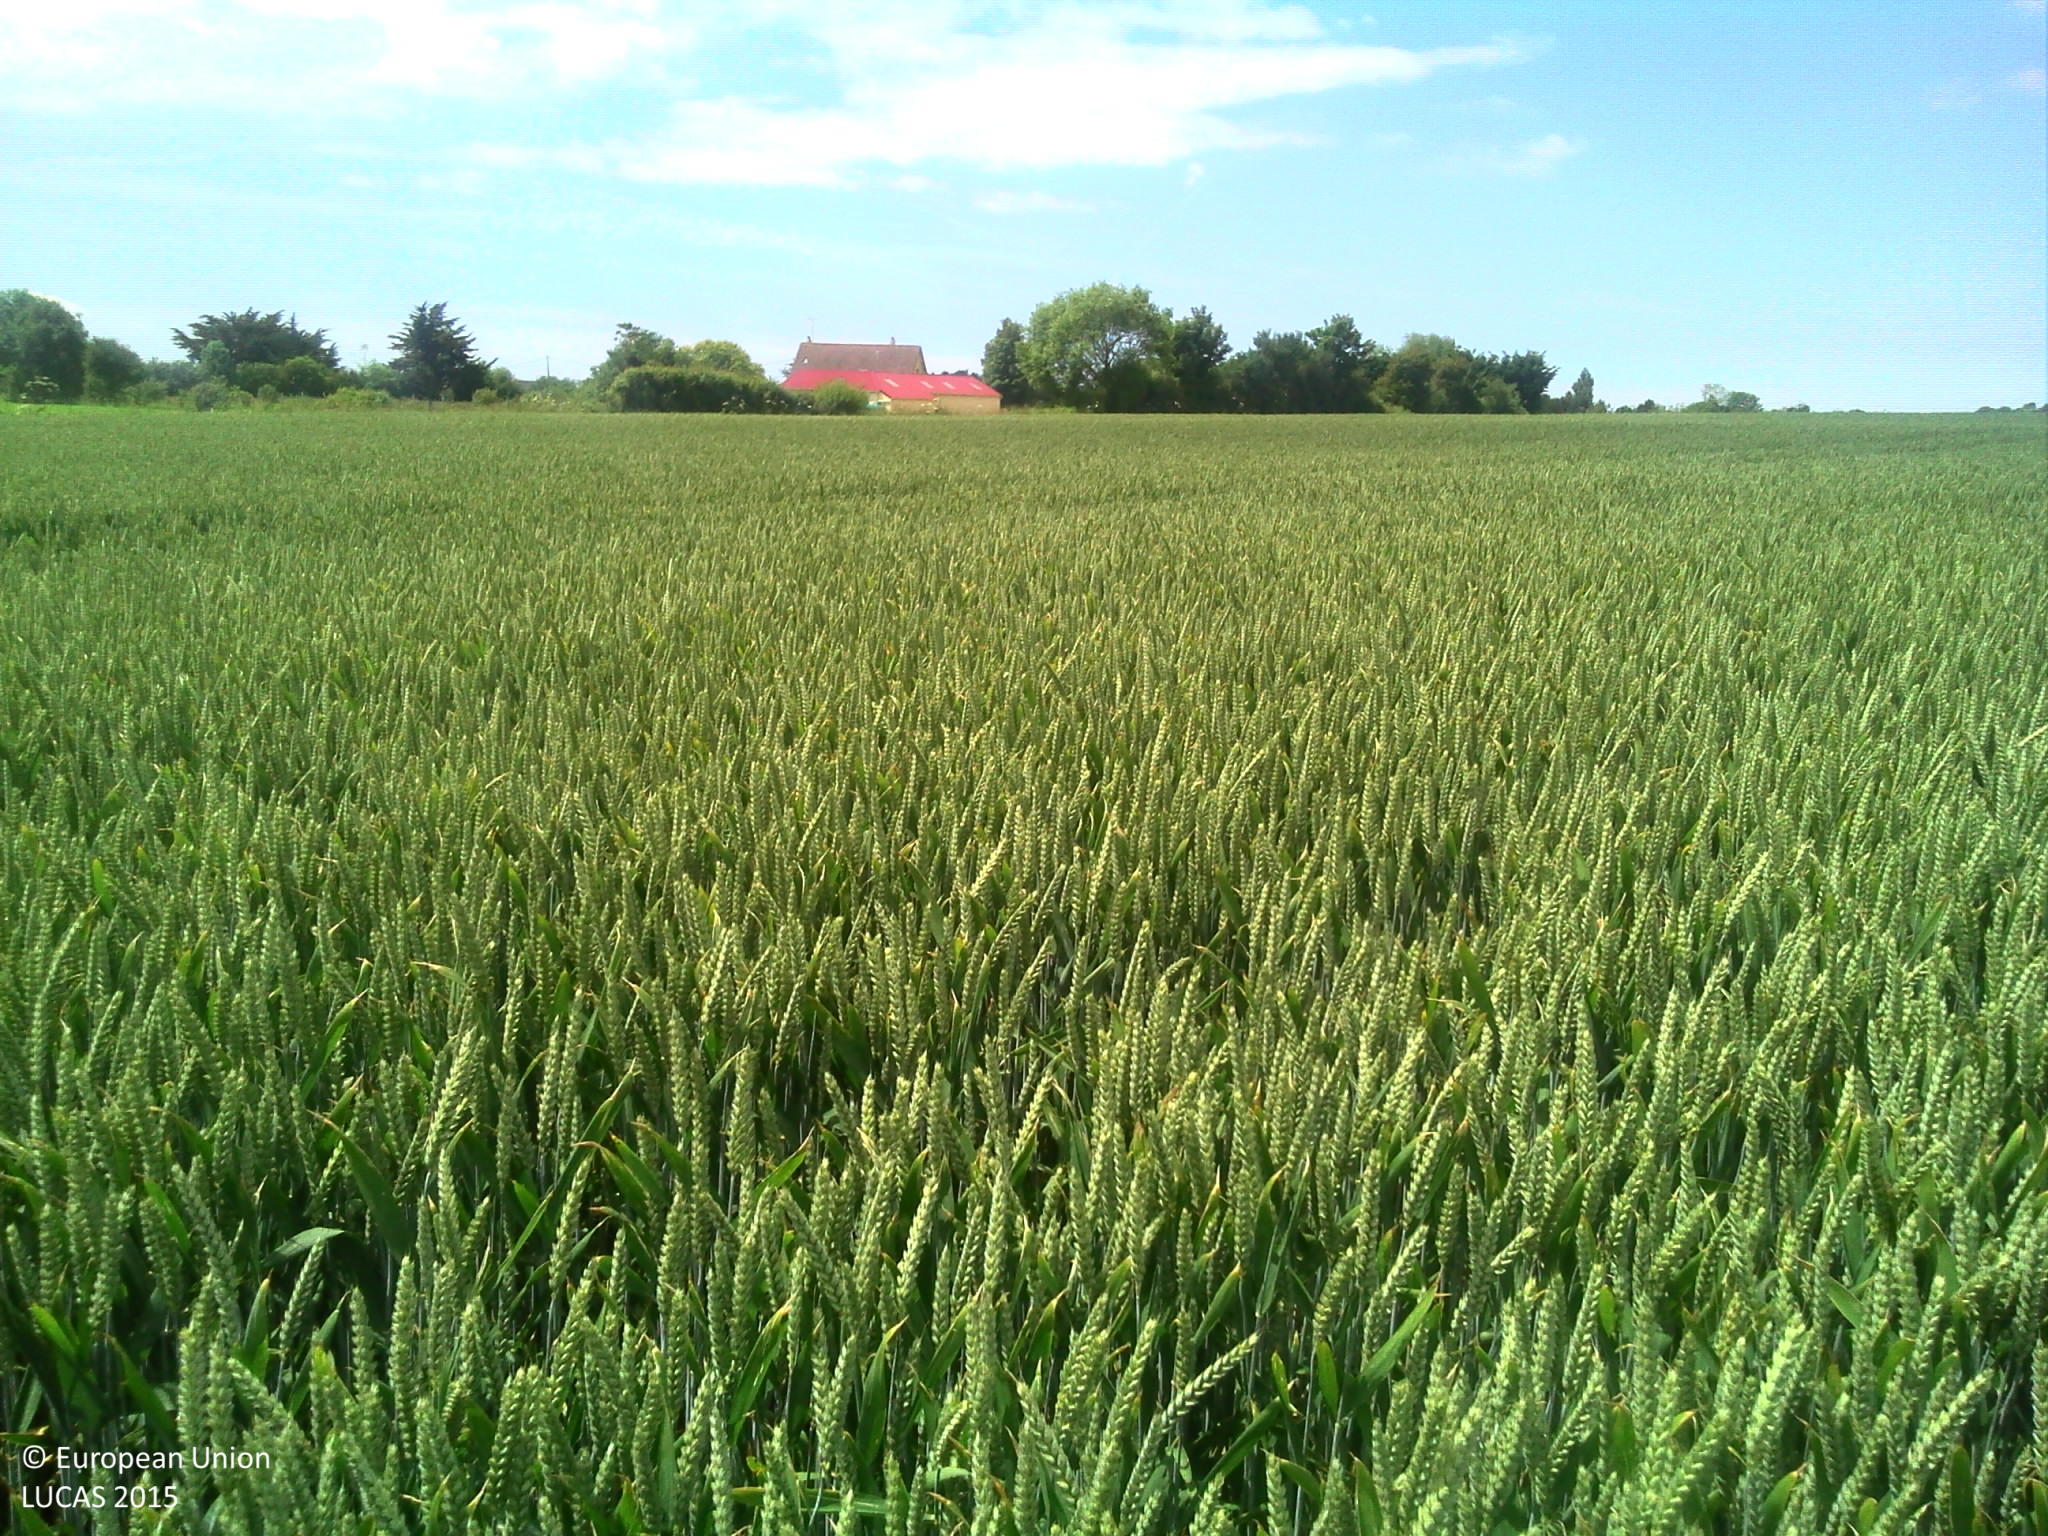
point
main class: Cropland
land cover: Common wheat
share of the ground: > 75 %
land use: Agriculture (excluding fallow land and kitchen gardens)
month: June
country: FR
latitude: 49.3450
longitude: -1.6826
